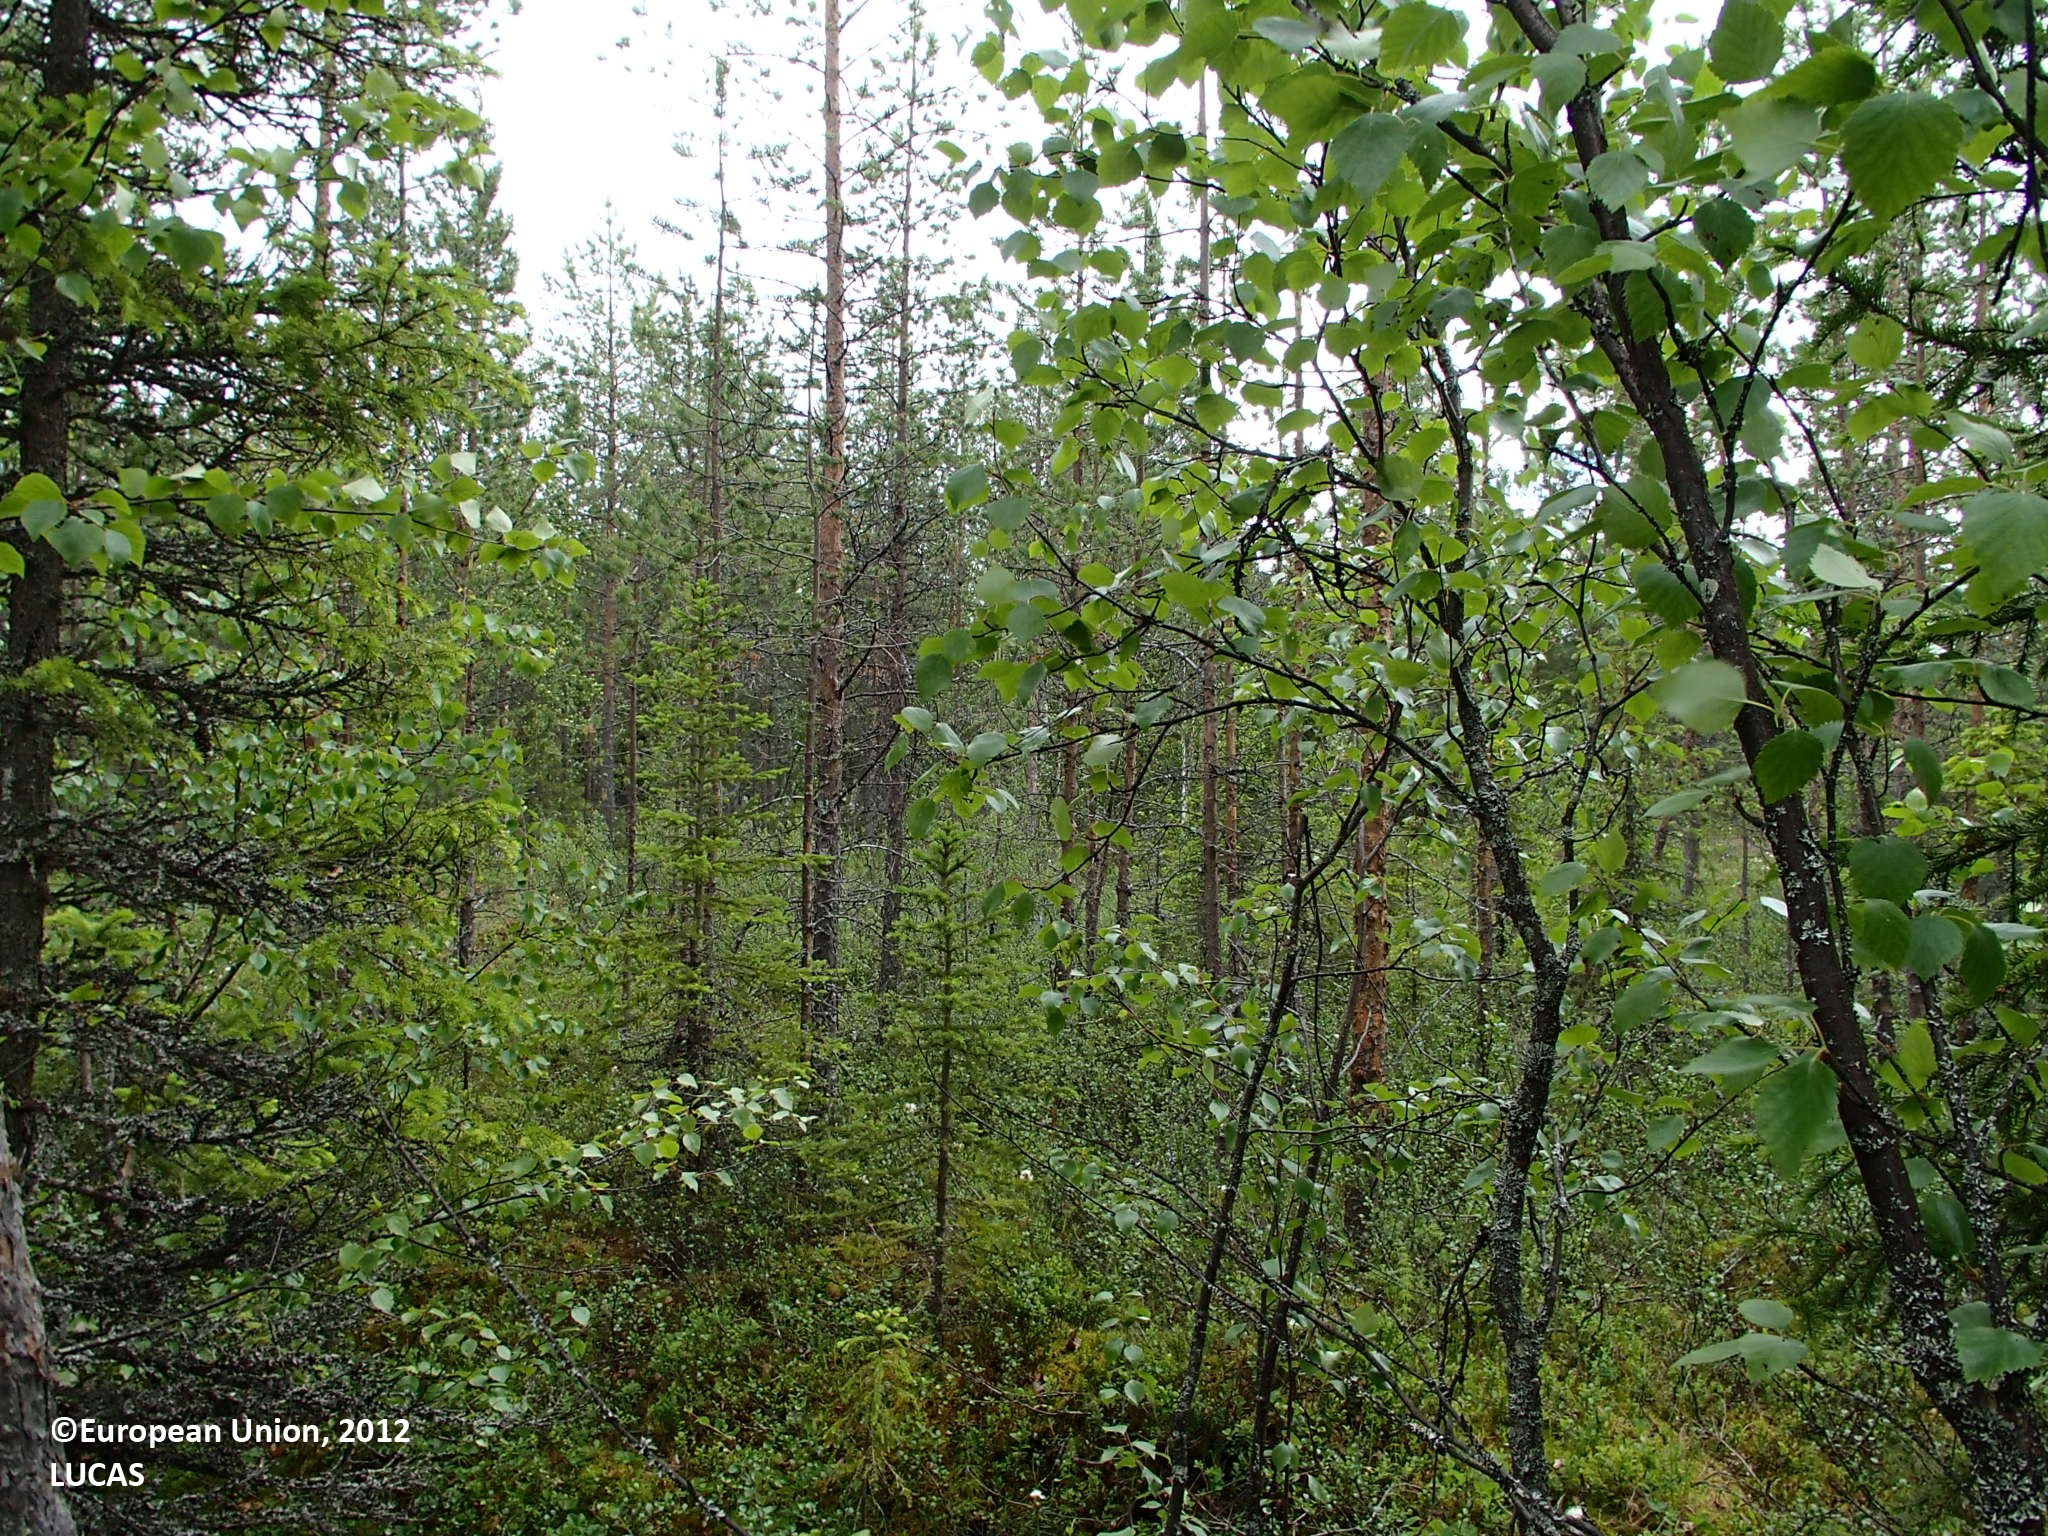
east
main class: Woodland
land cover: Spruce dominated coniferous woodland
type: boreal forest
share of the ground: > 75 %
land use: Forestry
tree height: > 5 m
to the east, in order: Spruce dominated coniferous woodland; Ditches and canals; Pine dominated coniferous woodland; Shrubland without tree cover; Electric lines; Shrubland without tree cover; Pine dominated coniferous woodland; Grassland without tree/shrub cover; Paved roads, cycling and walking lanes; Grassland without tree/shrub cover; Other mixed woodland
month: July
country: FI
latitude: 66.9462
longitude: 27.9471
